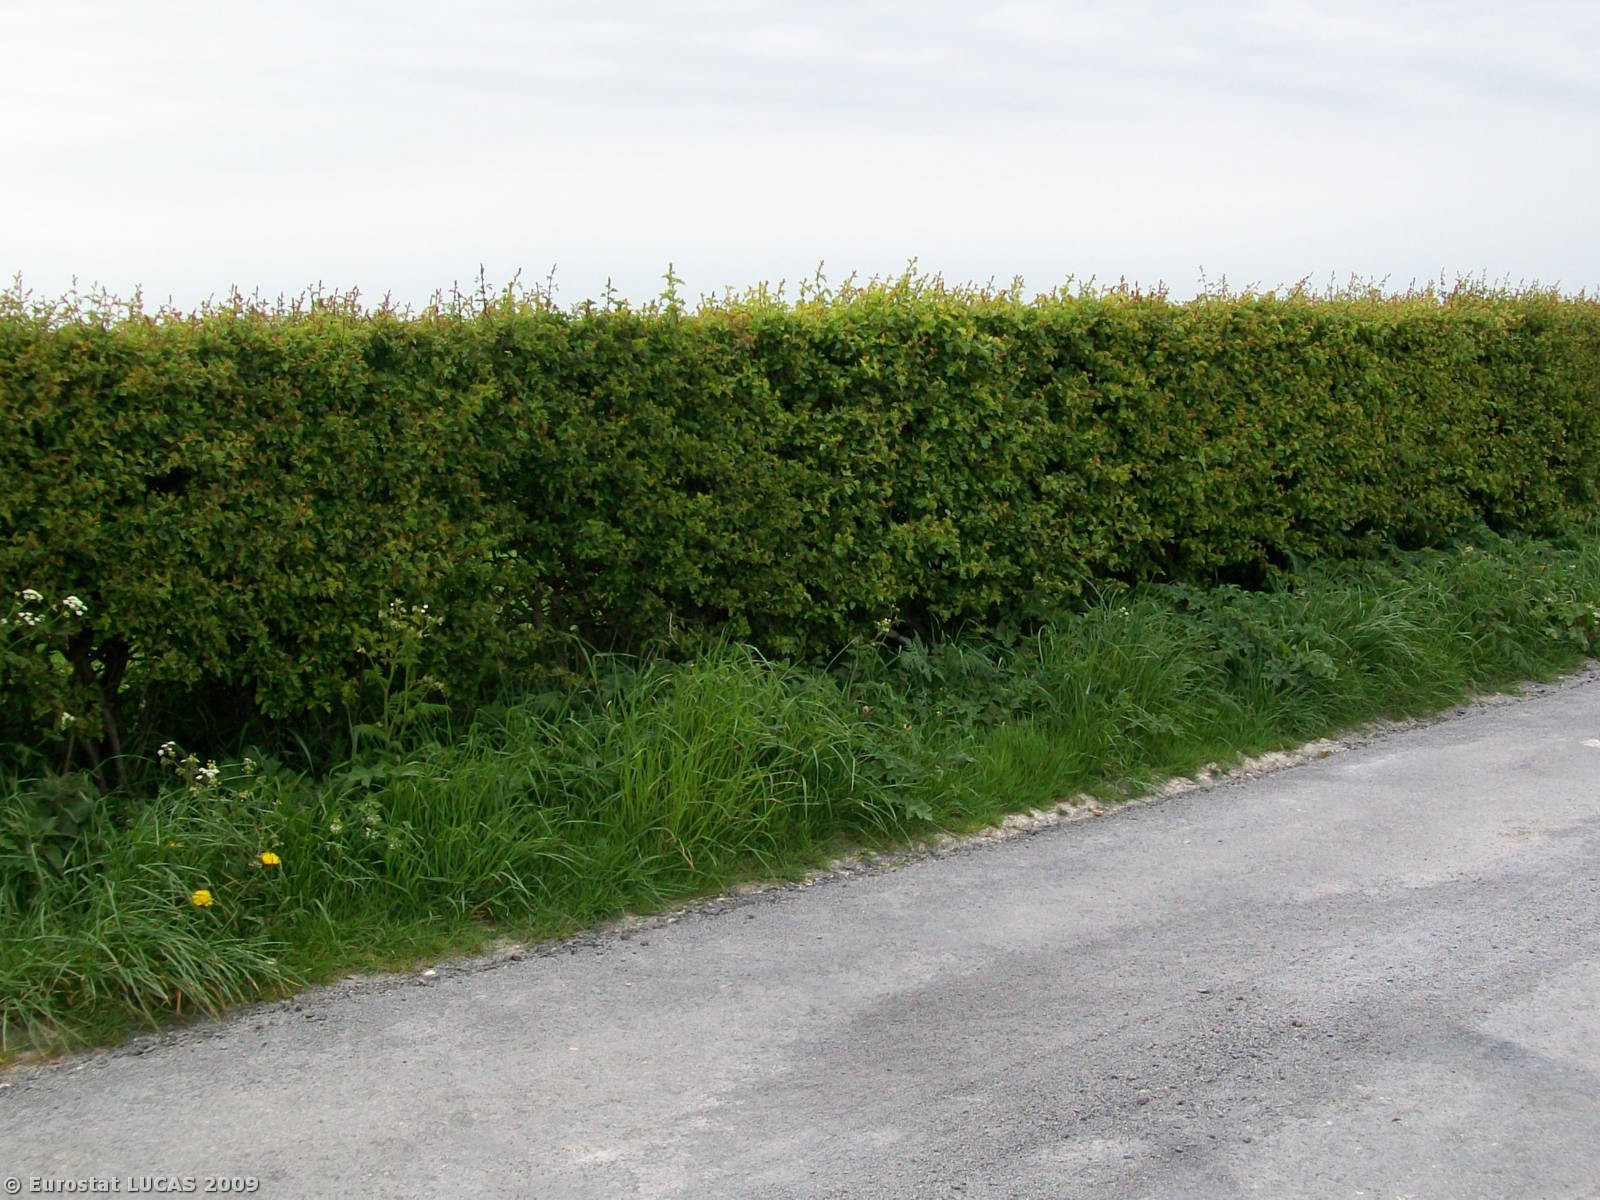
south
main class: Cropland
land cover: Common wheat
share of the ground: > 75 %
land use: Agriculture (excluding fallow land and kitchen gardens)
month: May
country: GB
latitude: 54.1903
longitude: -0.3487
